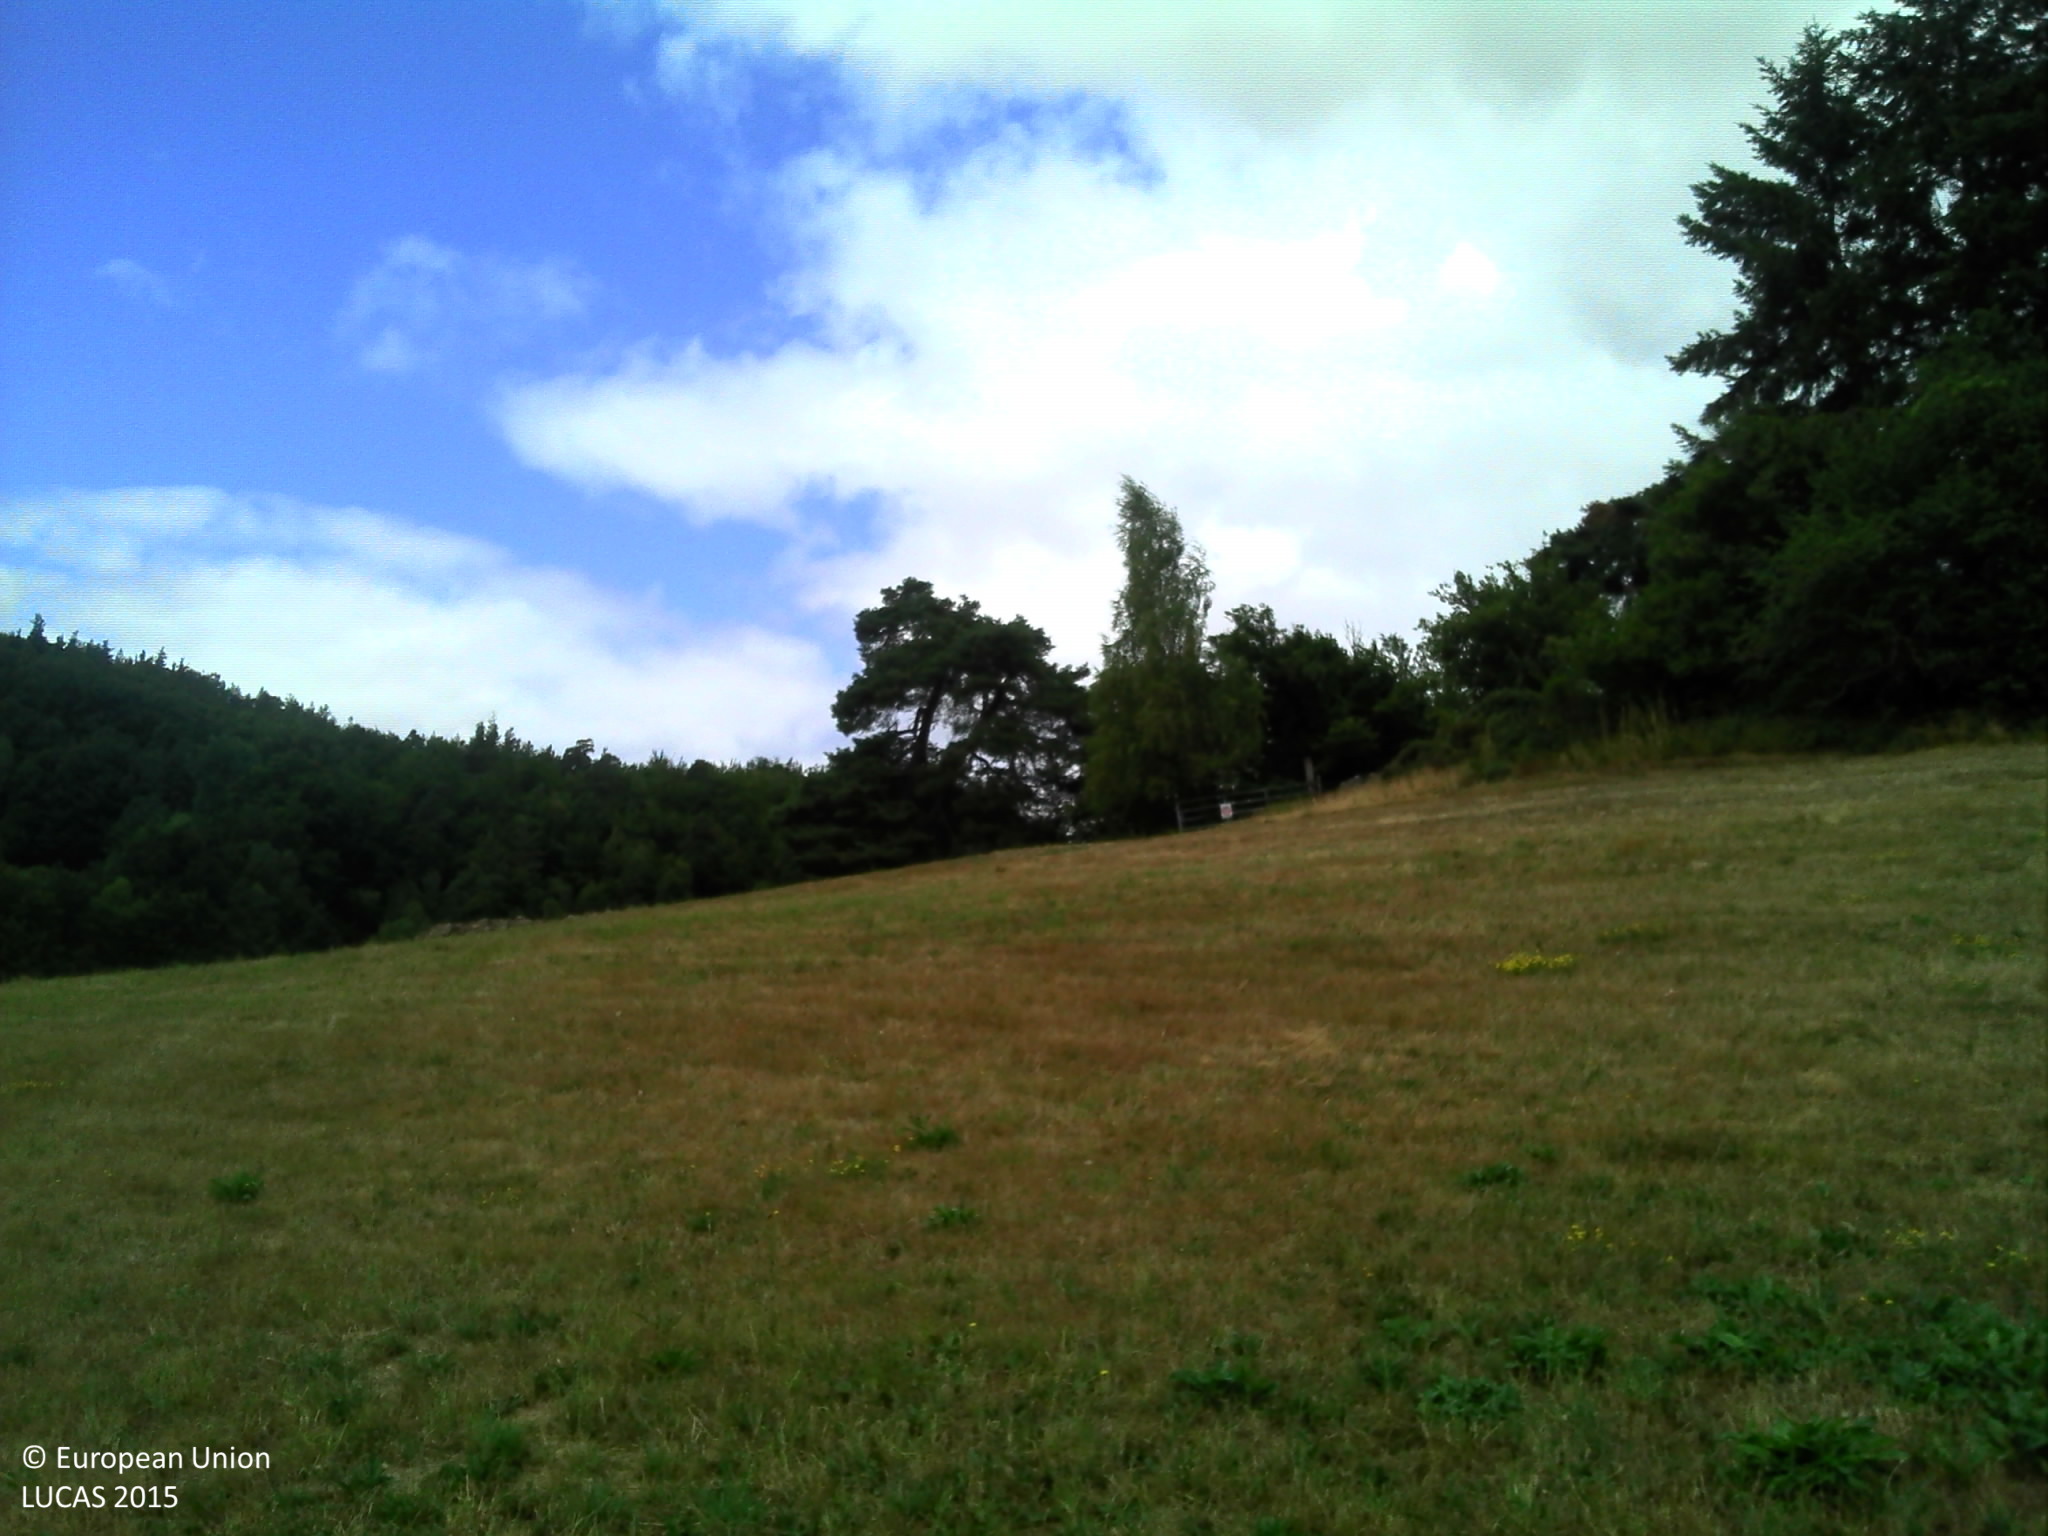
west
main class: Grassland
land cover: Grassland without tree/shrub cover
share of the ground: > 75 %
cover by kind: herbaceous plants 100 %
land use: Agriculture (excluding fallow land and kitchen gardens)
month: July
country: FR
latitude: 44.6395
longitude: 3.2847
